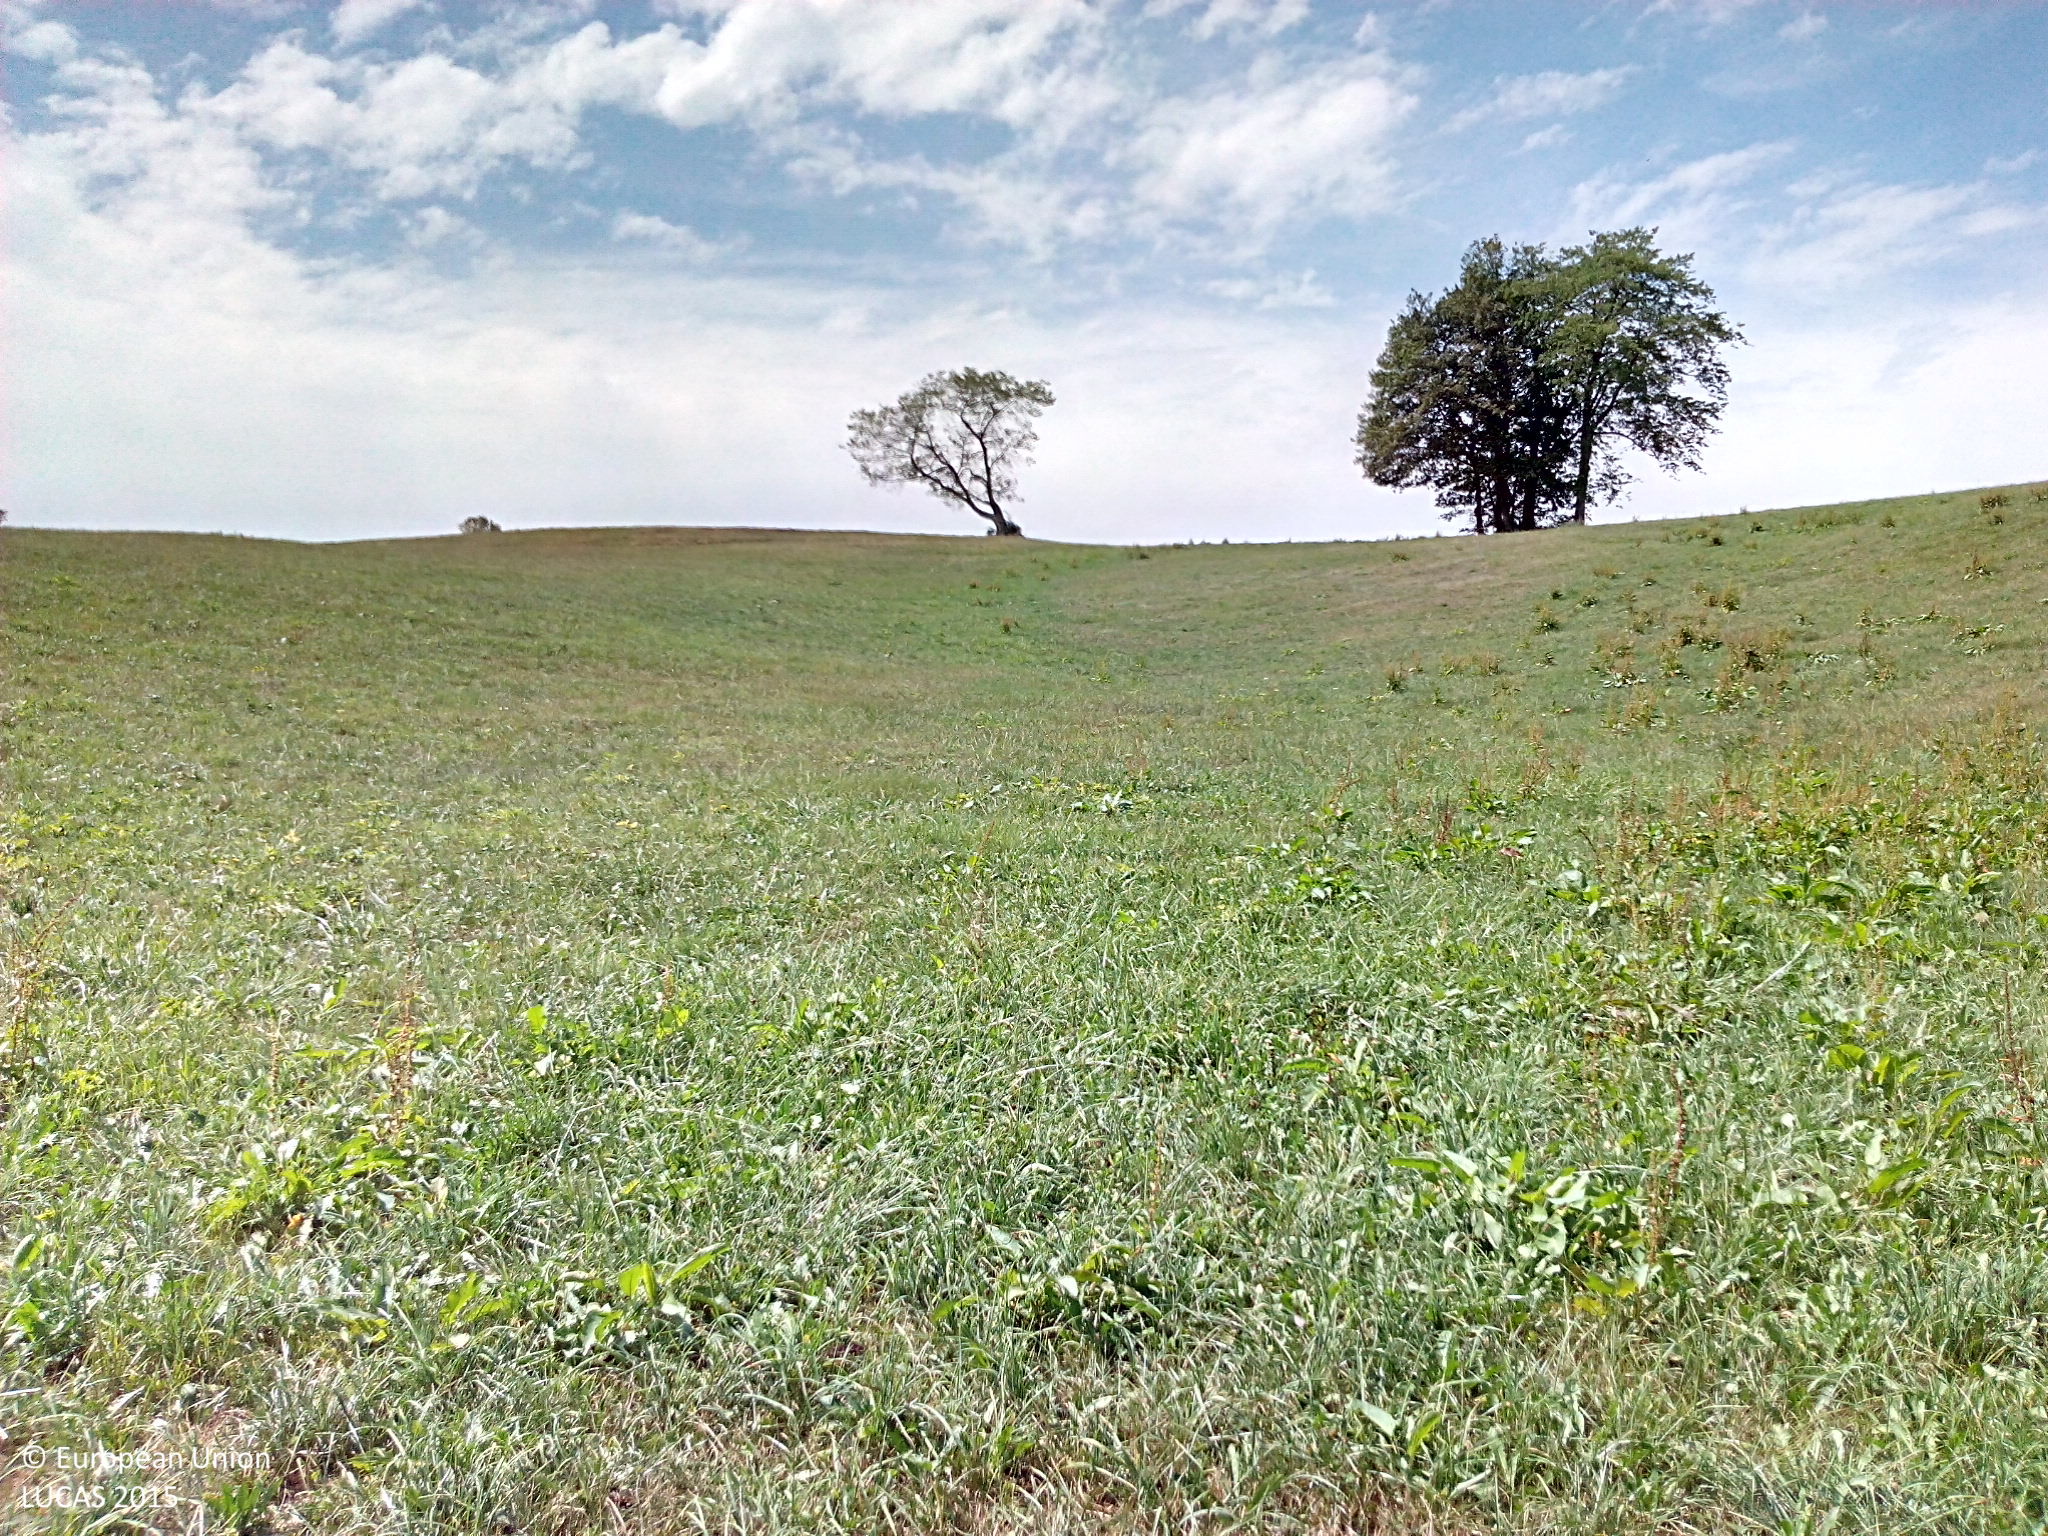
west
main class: Grassland
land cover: Grassland without tree/shrub cover
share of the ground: > 75 %
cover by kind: herbaceous plants 100 %
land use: Agriculture (excluding fallow land and kitchen gardens)
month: August
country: DE
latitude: 47.6495
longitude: 8.1242
